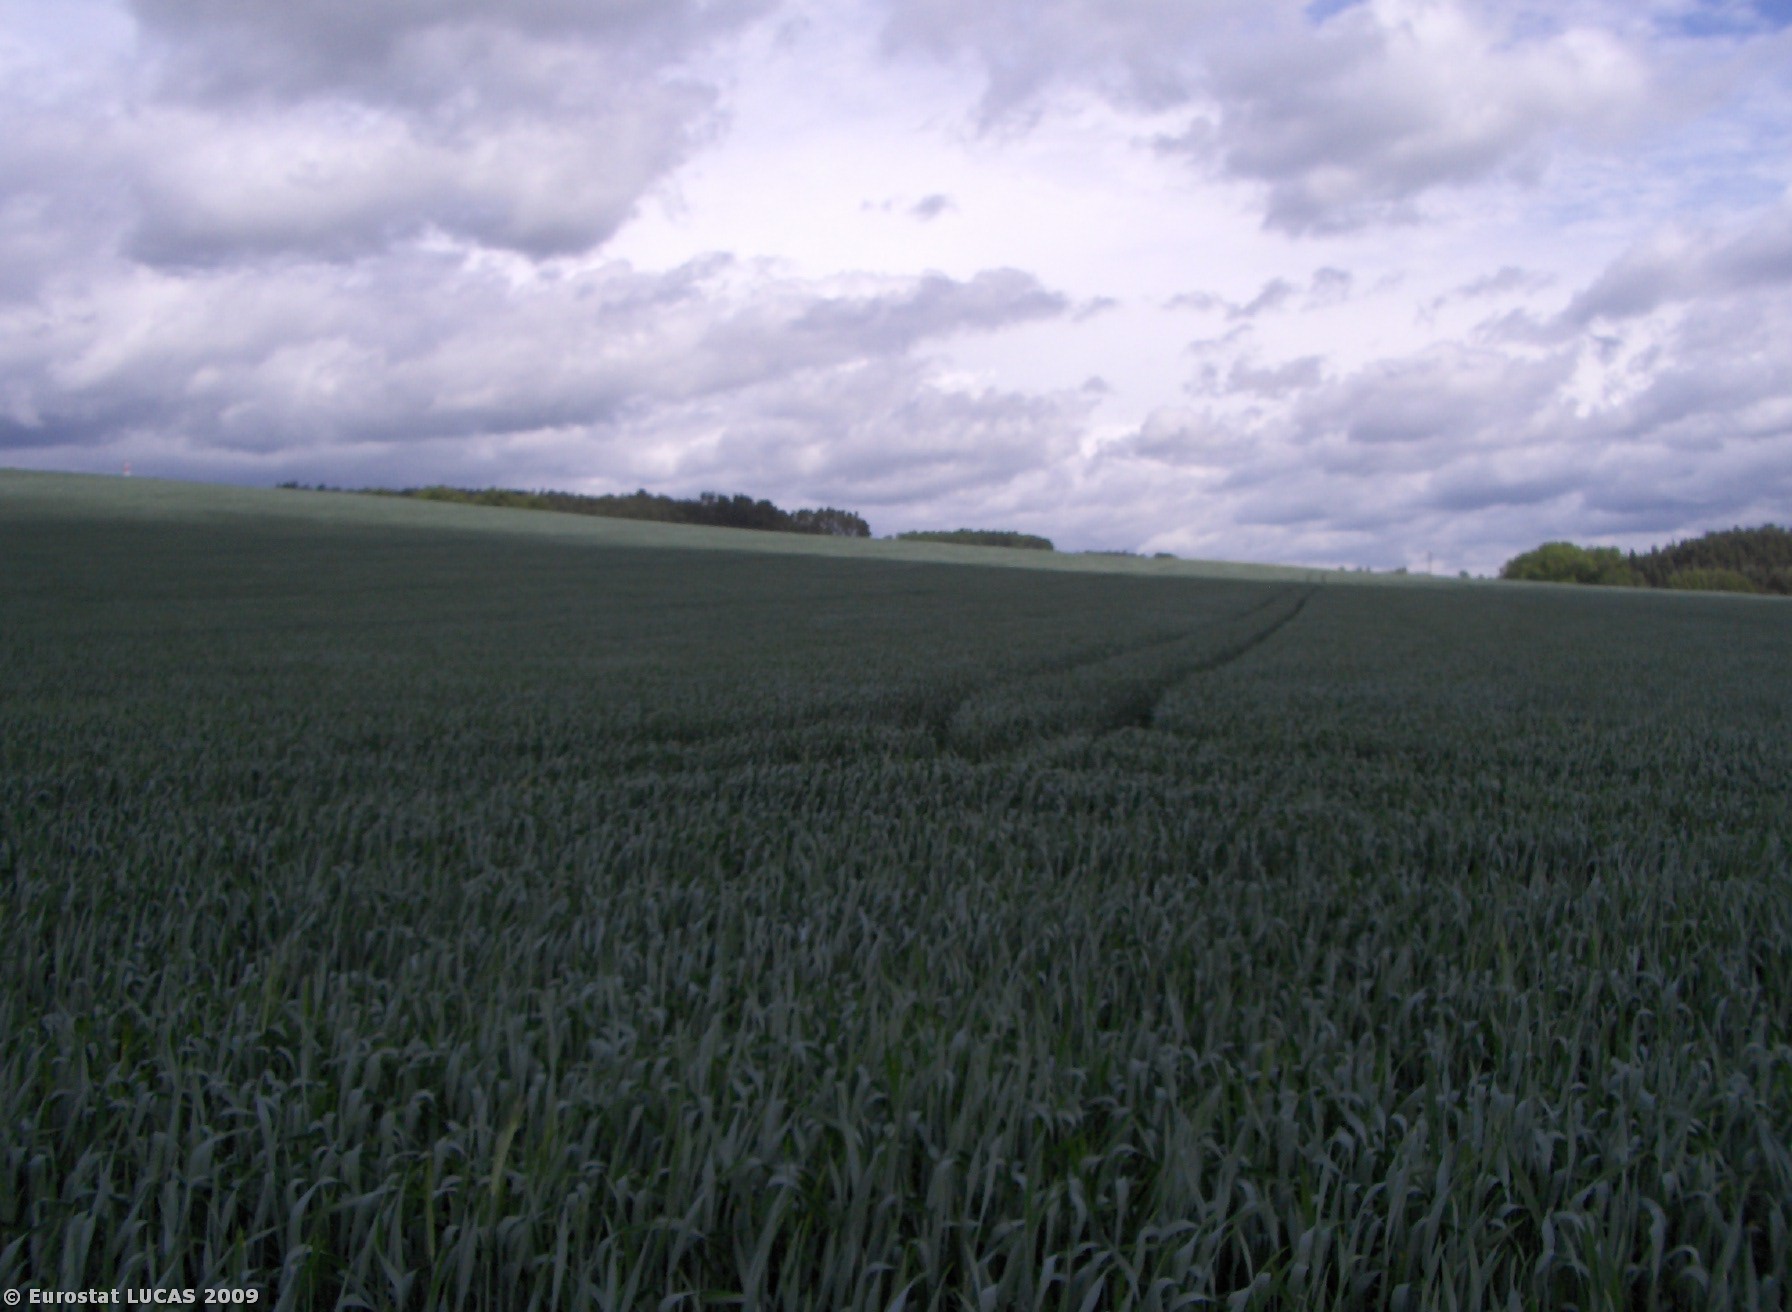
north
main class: Cropland
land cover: Common wheat
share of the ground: > 75 %
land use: Agriculture (excluding fallow land and kitchen gardens)
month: May
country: CZ
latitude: 49.3274
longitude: 14.3353
